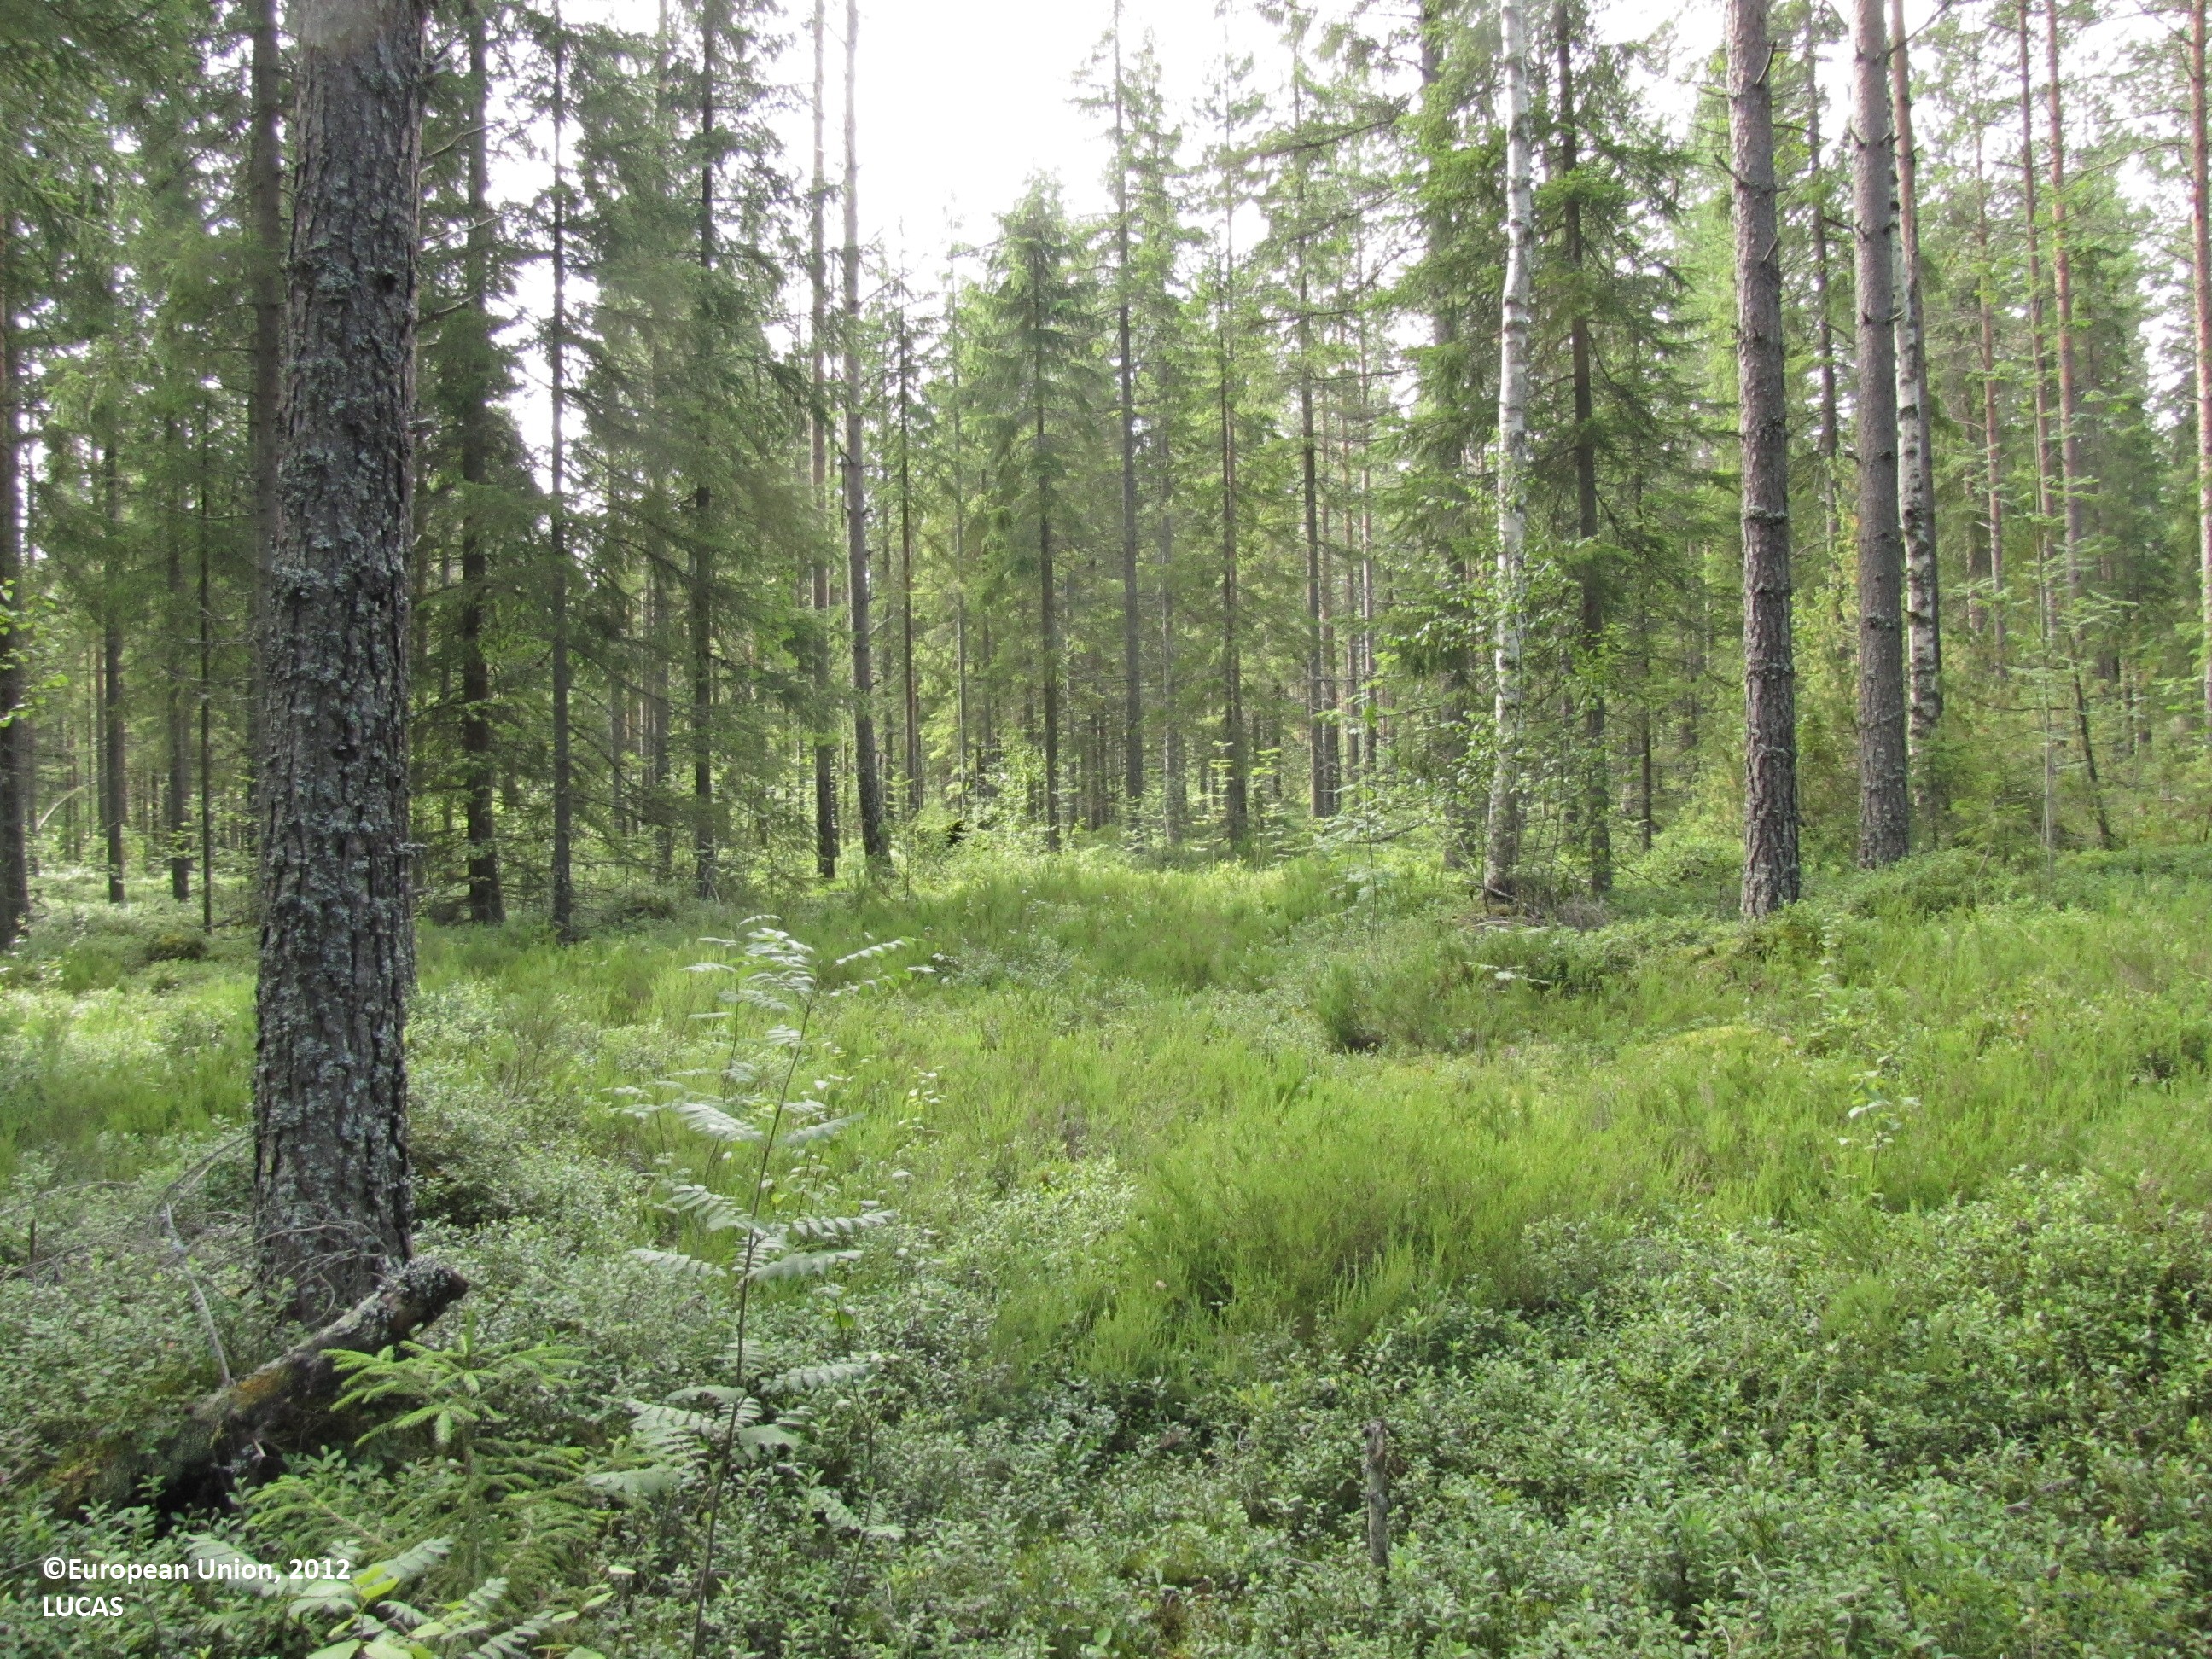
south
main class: Woodland
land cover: Other coniferous woodland
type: boreal forest
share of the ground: 50 - 75 %
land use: Forestry
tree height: > 5 m
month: July
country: FI
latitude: 62.2112
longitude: 23.2006
